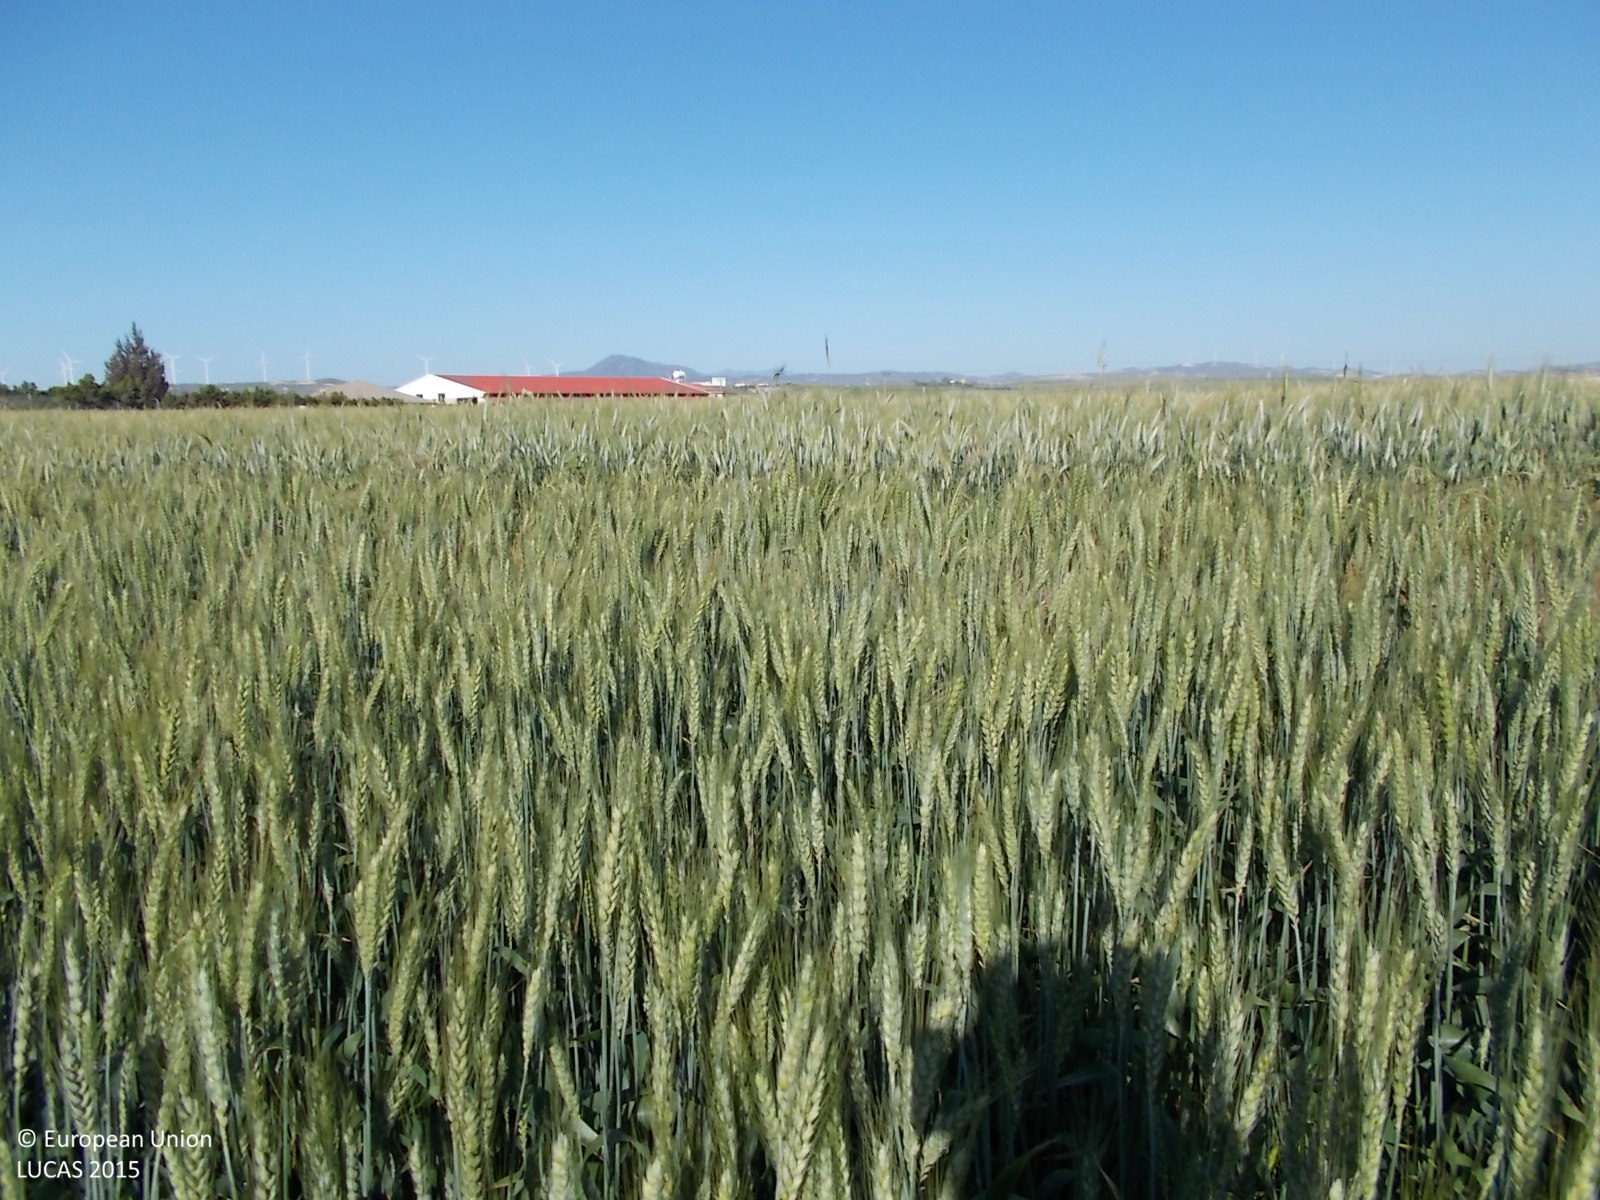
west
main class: Cropland
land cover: Common wheat
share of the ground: > 75 %
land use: Agriculture (excluding fallow land and kitchen gardens)
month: April
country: CY
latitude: 34.8887
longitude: 33.5762
